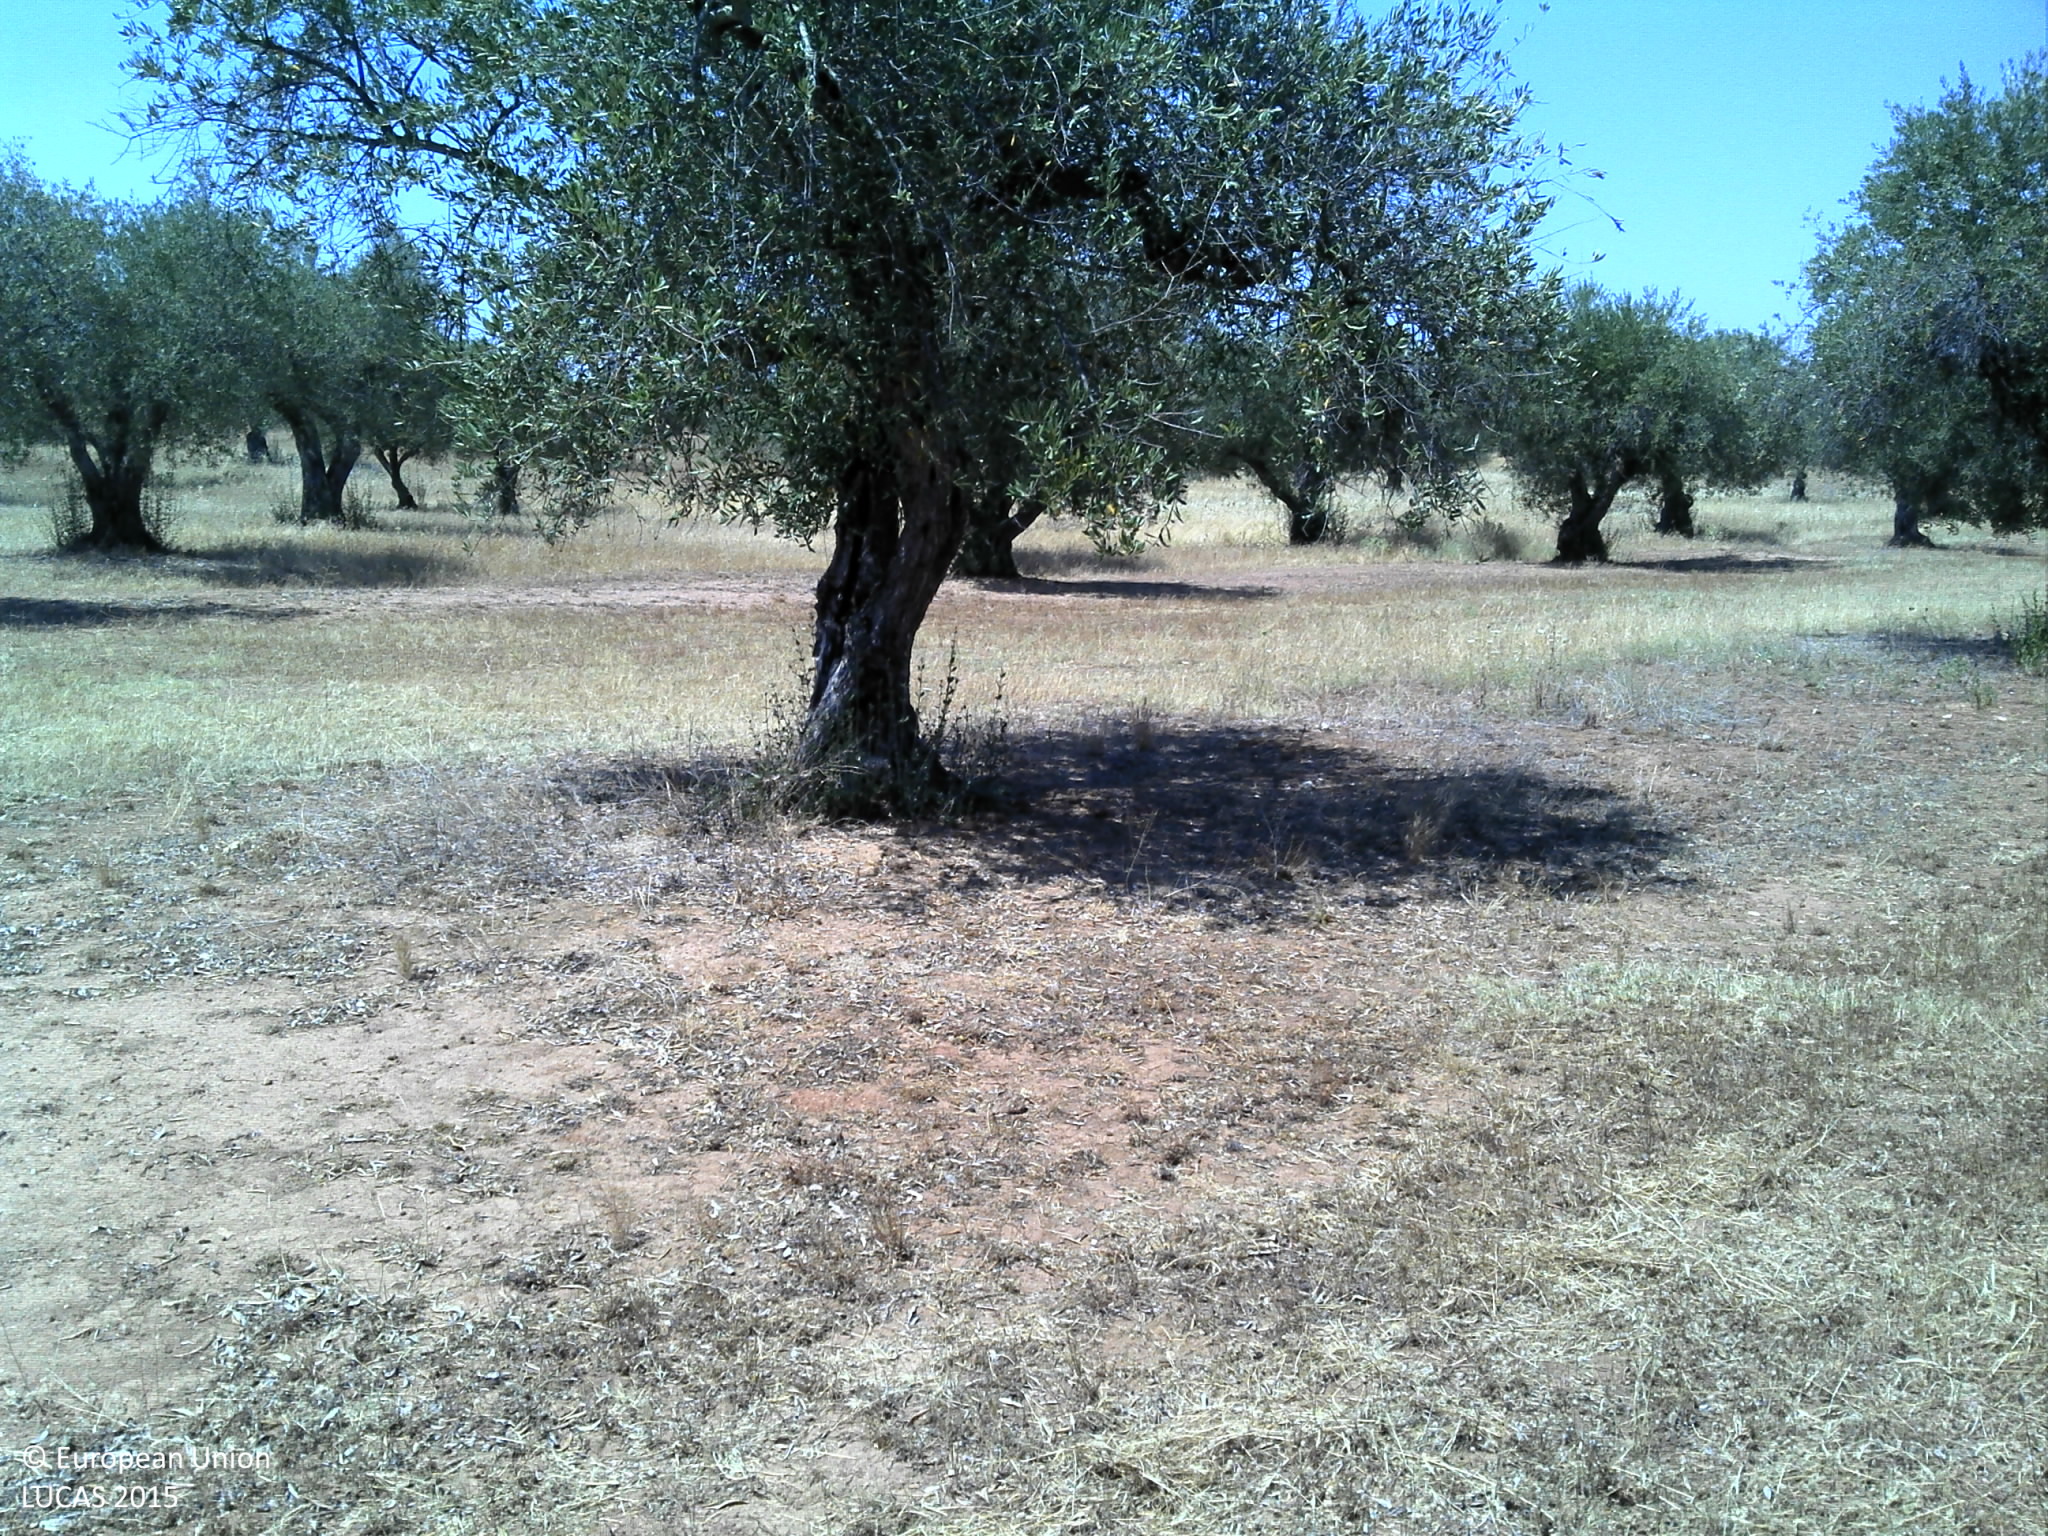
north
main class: Cropland
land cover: Olive groves
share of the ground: 25 - 50 %
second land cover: Grassland without tree/shrub cover
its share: 10 - 25 %
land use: Agriculture (excluding fallow land and kitchen gardens)
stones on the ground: < 10 %
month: June
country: PT
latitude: 38.0419
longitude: -7.5573
